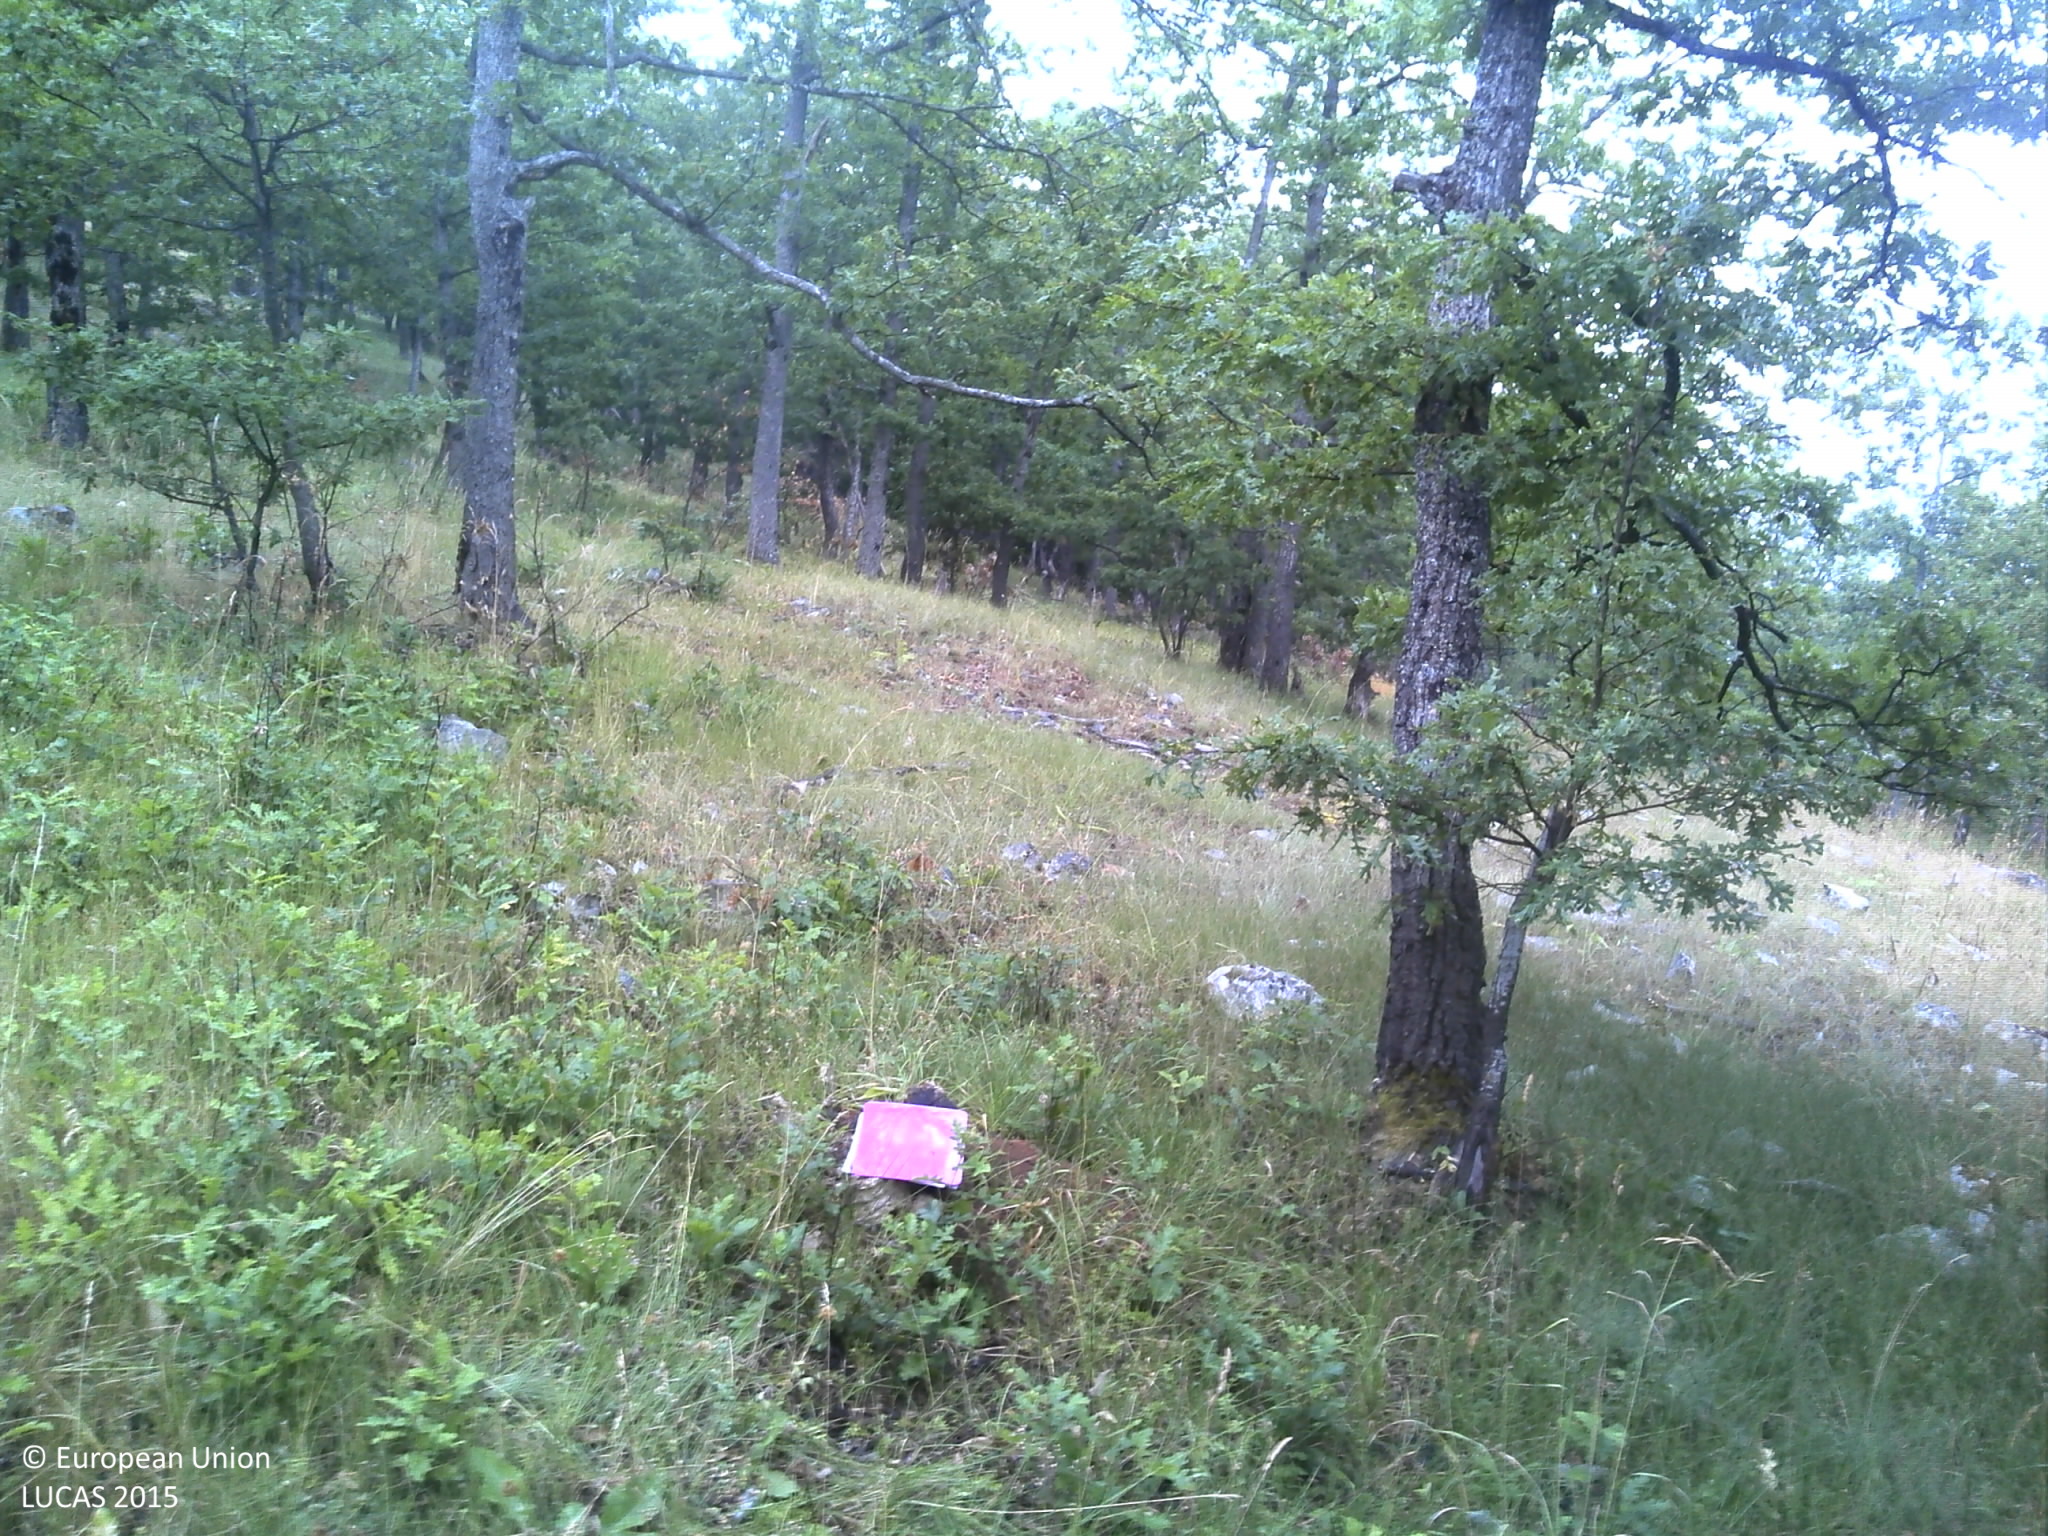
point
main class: Woodland
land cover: Broadleaved woodland
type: beech forest
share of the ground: 50 - 75 %
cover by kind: broadleaved forest trees 50 %, herbaceous plants 40 %, shrubs 10 %
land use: Semi-natural and natural areas not in use
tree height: > 5 m
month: July
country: HR
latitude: 44.4265
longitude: 16.0608
